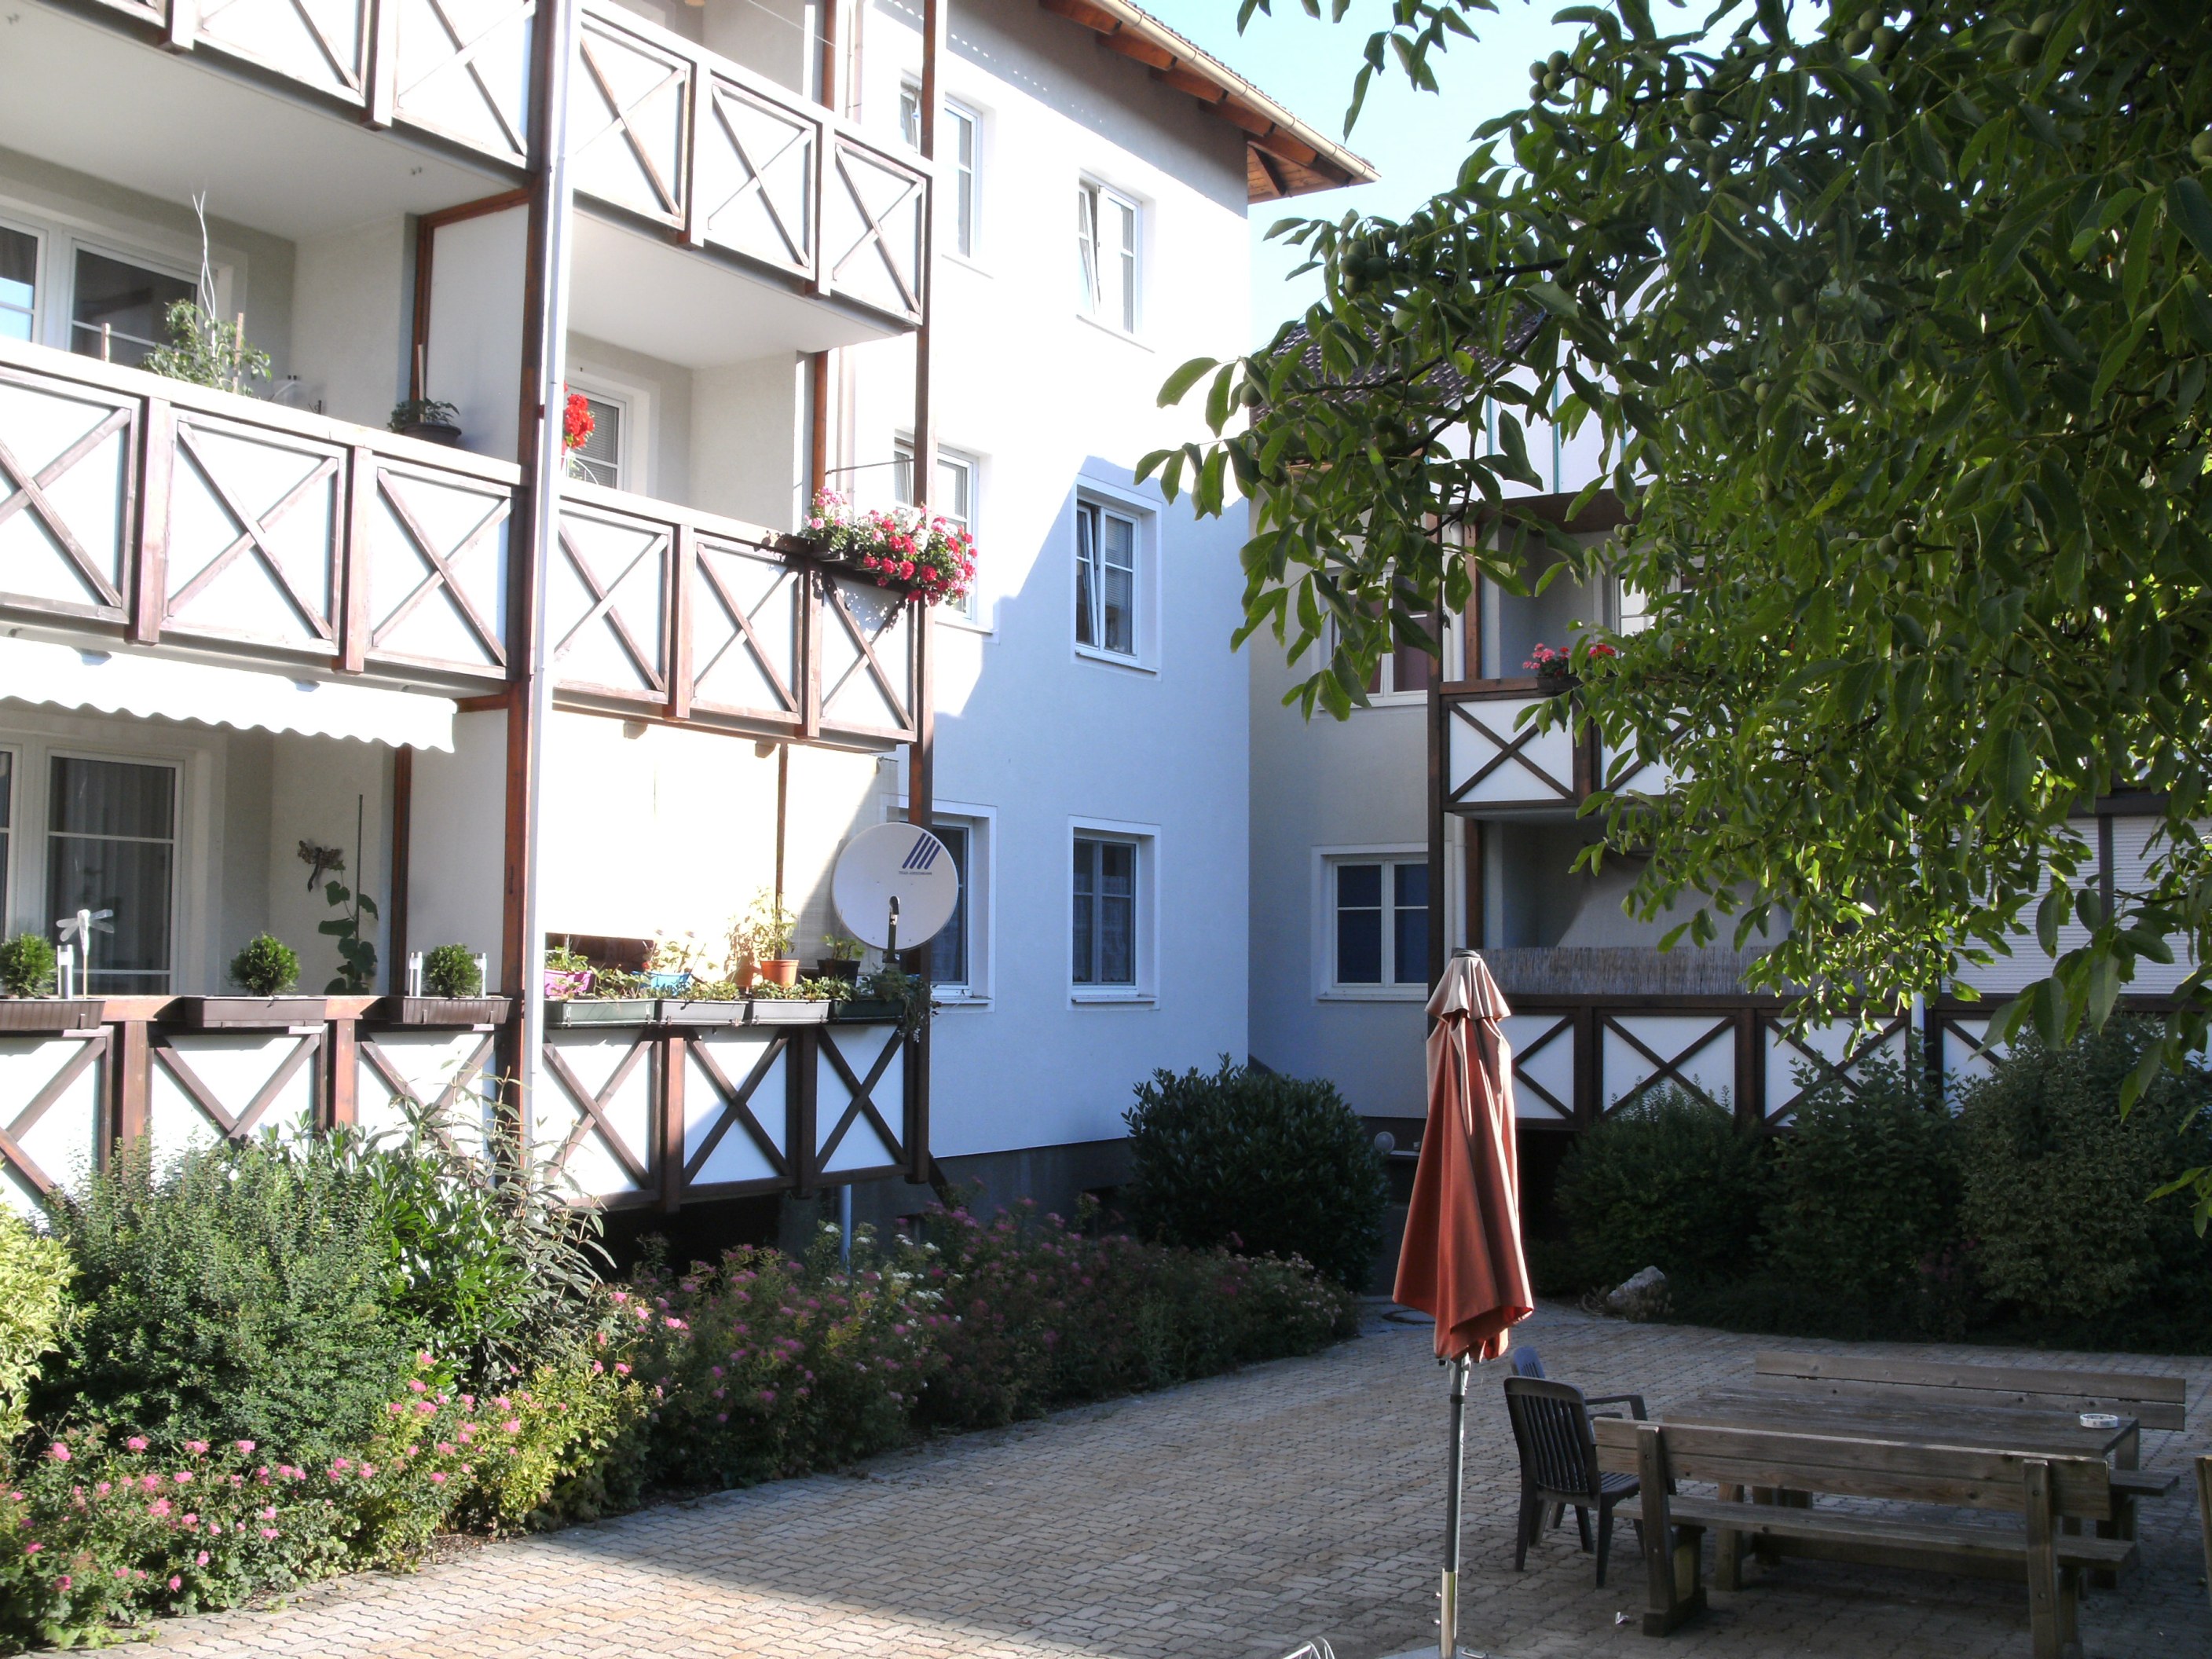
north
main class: Grassland
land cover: Grassland with sparse tree/shrub cover
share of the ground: > 75 %
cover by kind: herbaceous plants 95 %, broadleaved forest trees 5 %
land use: Amenities, museums, leisure
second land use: Residential
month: July
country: AT
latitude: 48.2045
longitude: 13.4843
